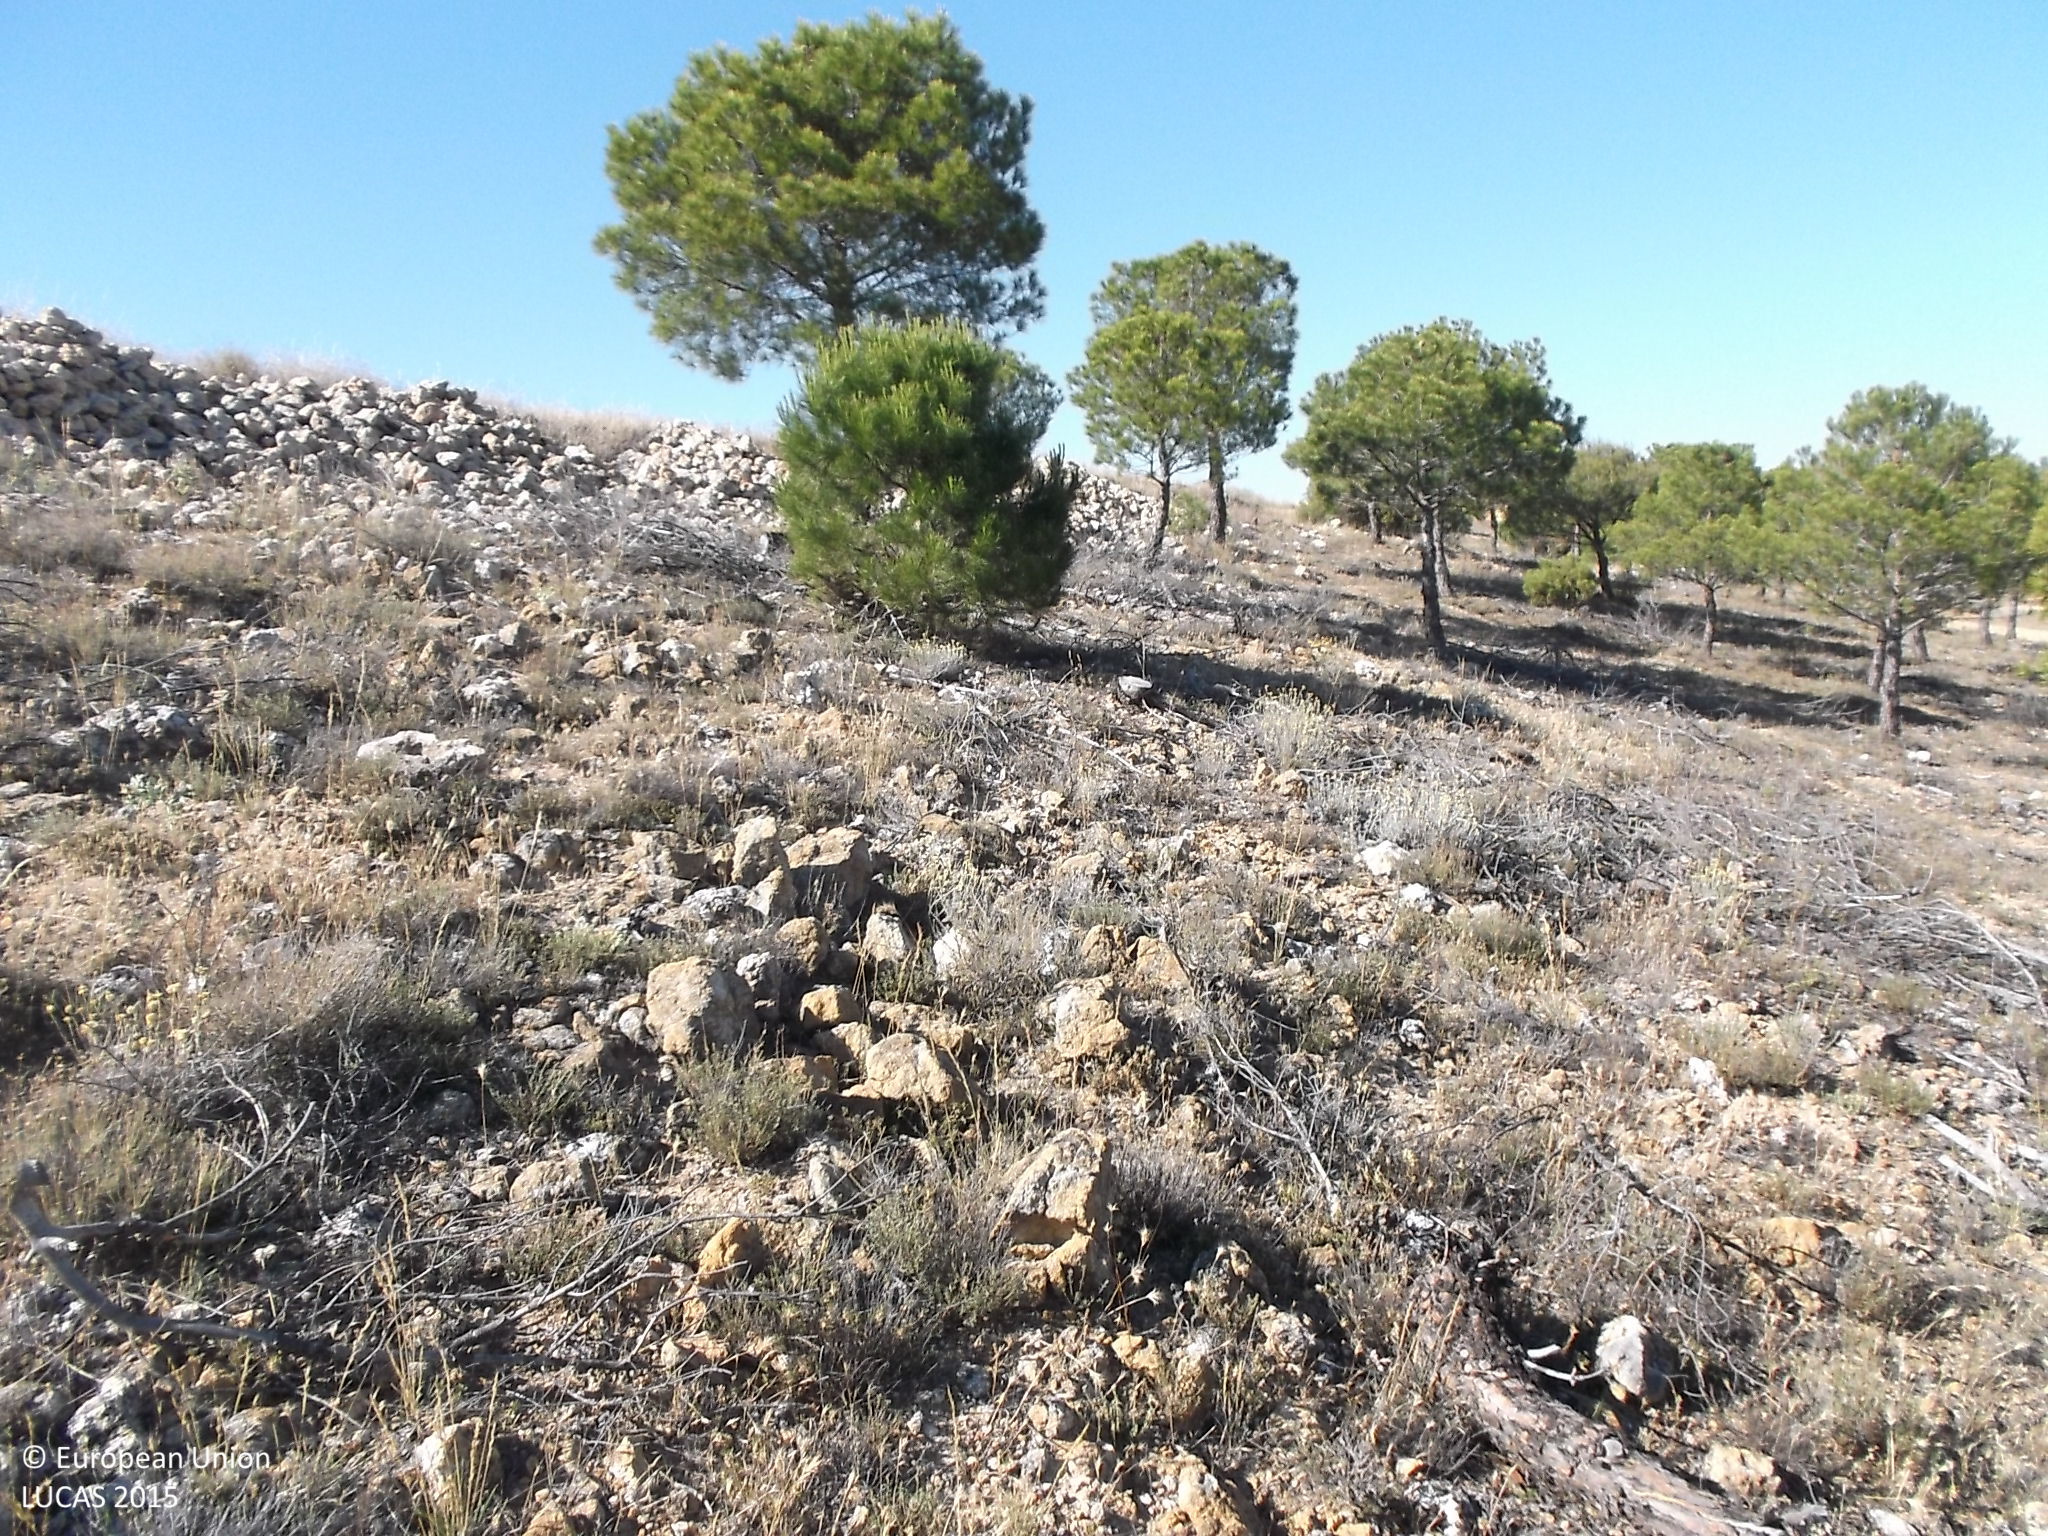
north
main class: Woodland
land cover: Pine dominated coniferous woodland
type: coniferous forest of the mediterranean region
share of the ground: 25 - 50 %
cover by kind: herbaceous plants 65 %, coniferous forest trees 35 %
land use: Forestry
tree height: < 5 m
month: June
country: ES
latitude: 41.3175
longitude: -5.3064
